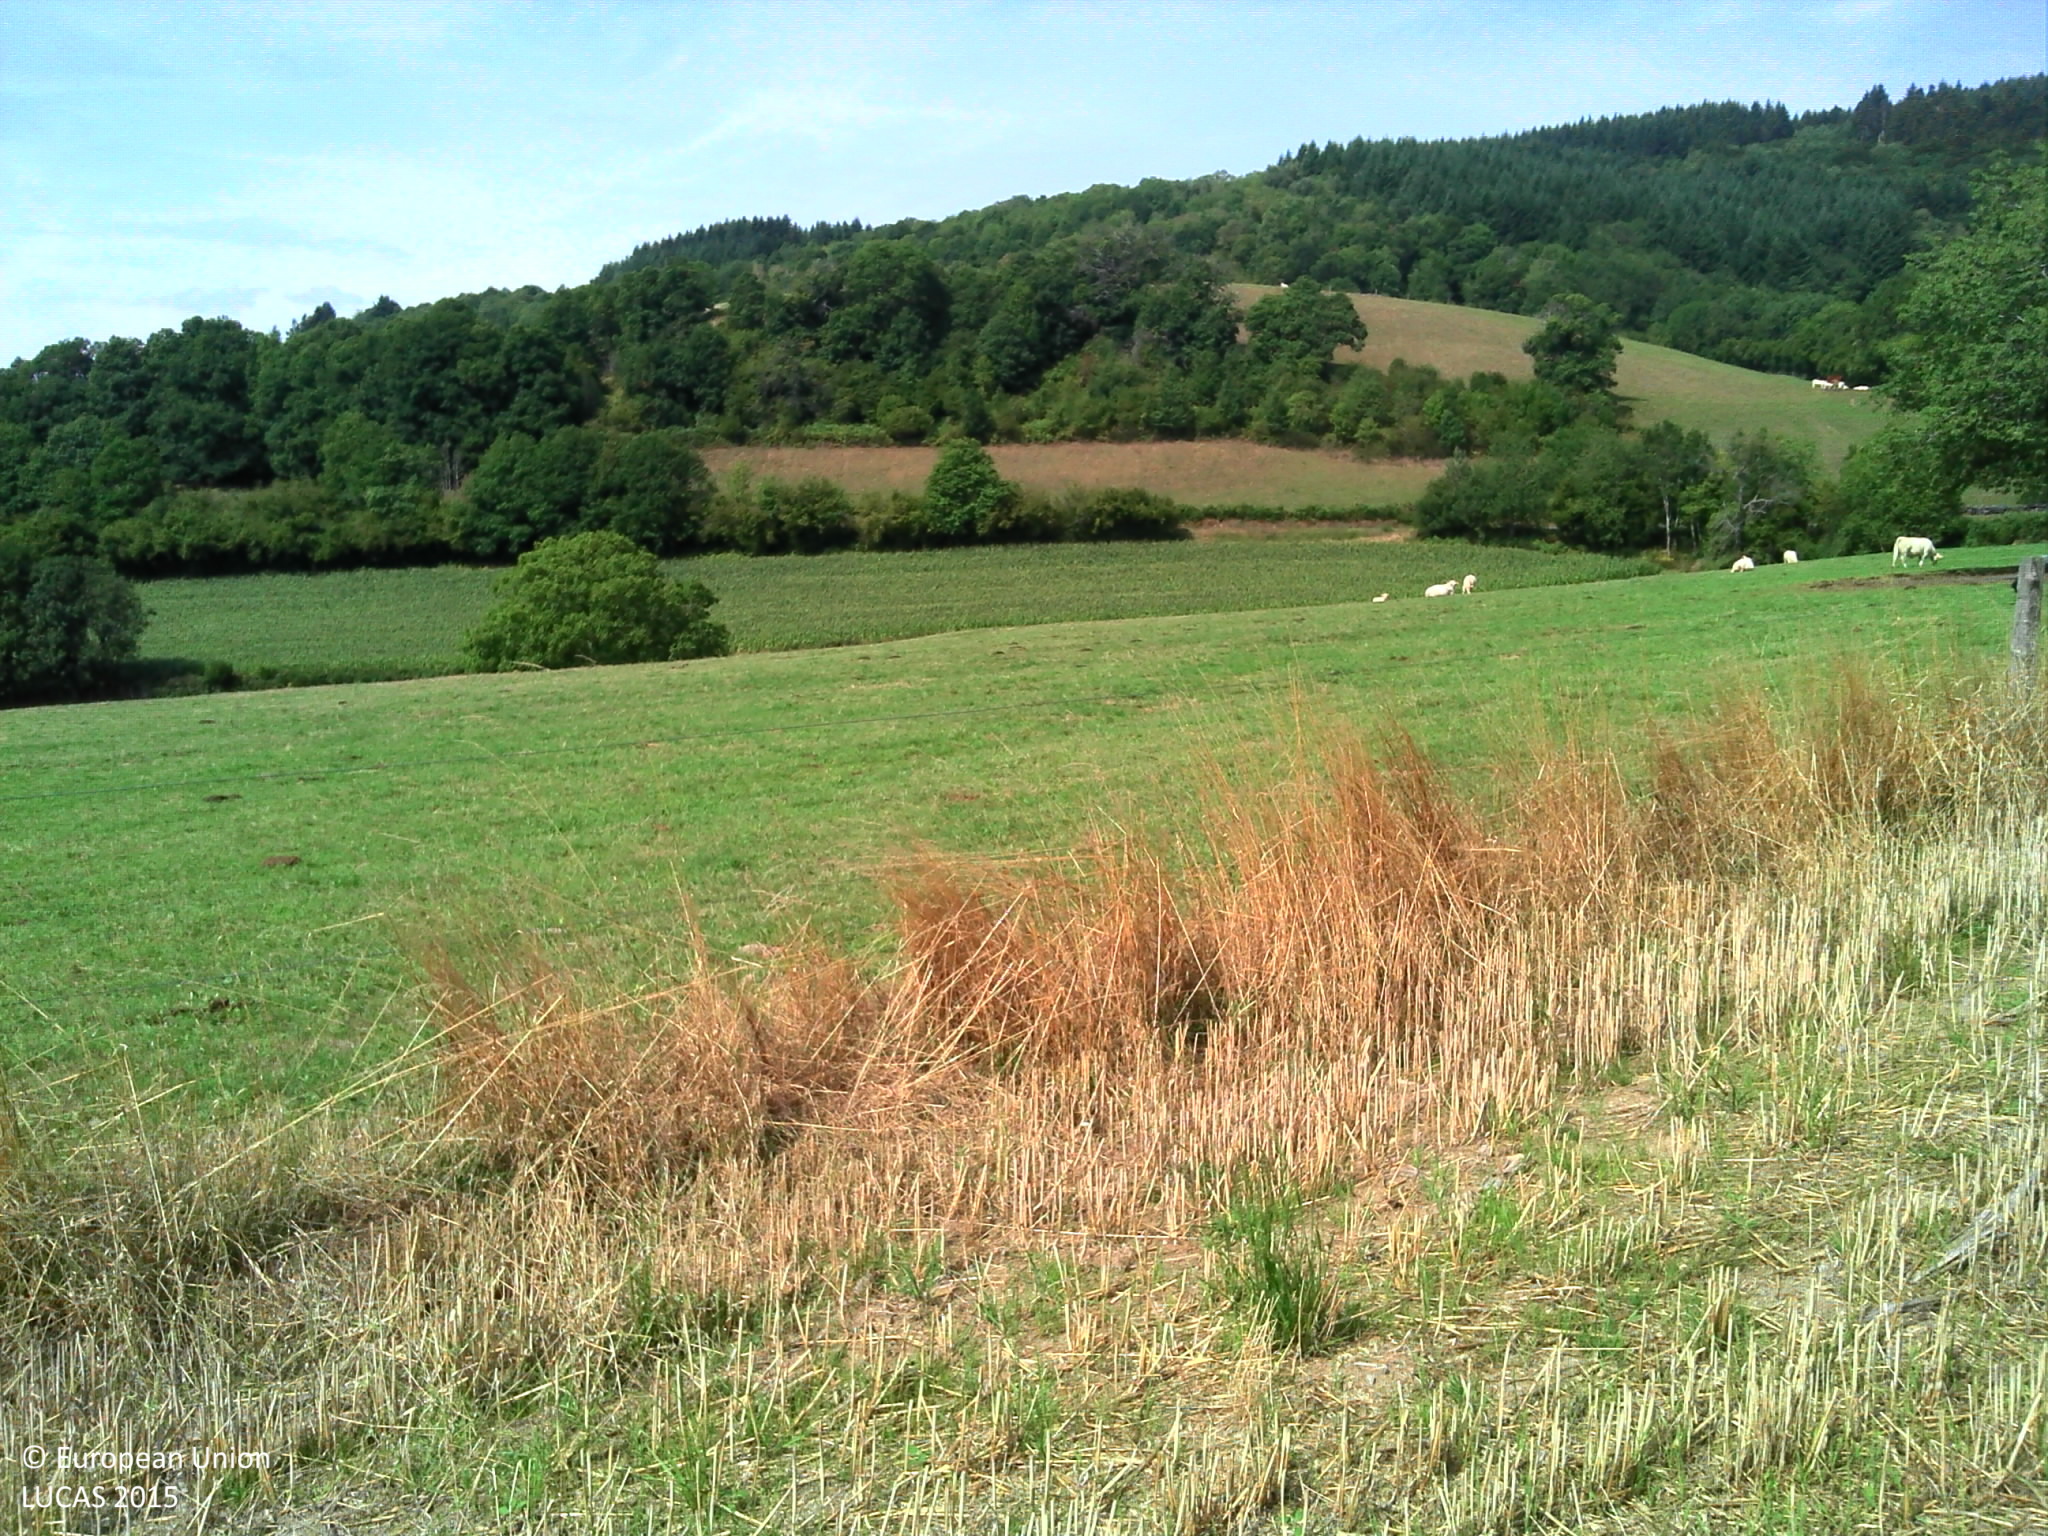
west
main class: Cropland
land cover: Common wheat
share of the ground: 50 - 75 %
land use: Agriculture (excluding fallow land and kitchen gardens)
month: August
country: FR
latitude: 46.1927
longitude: 4.5211
